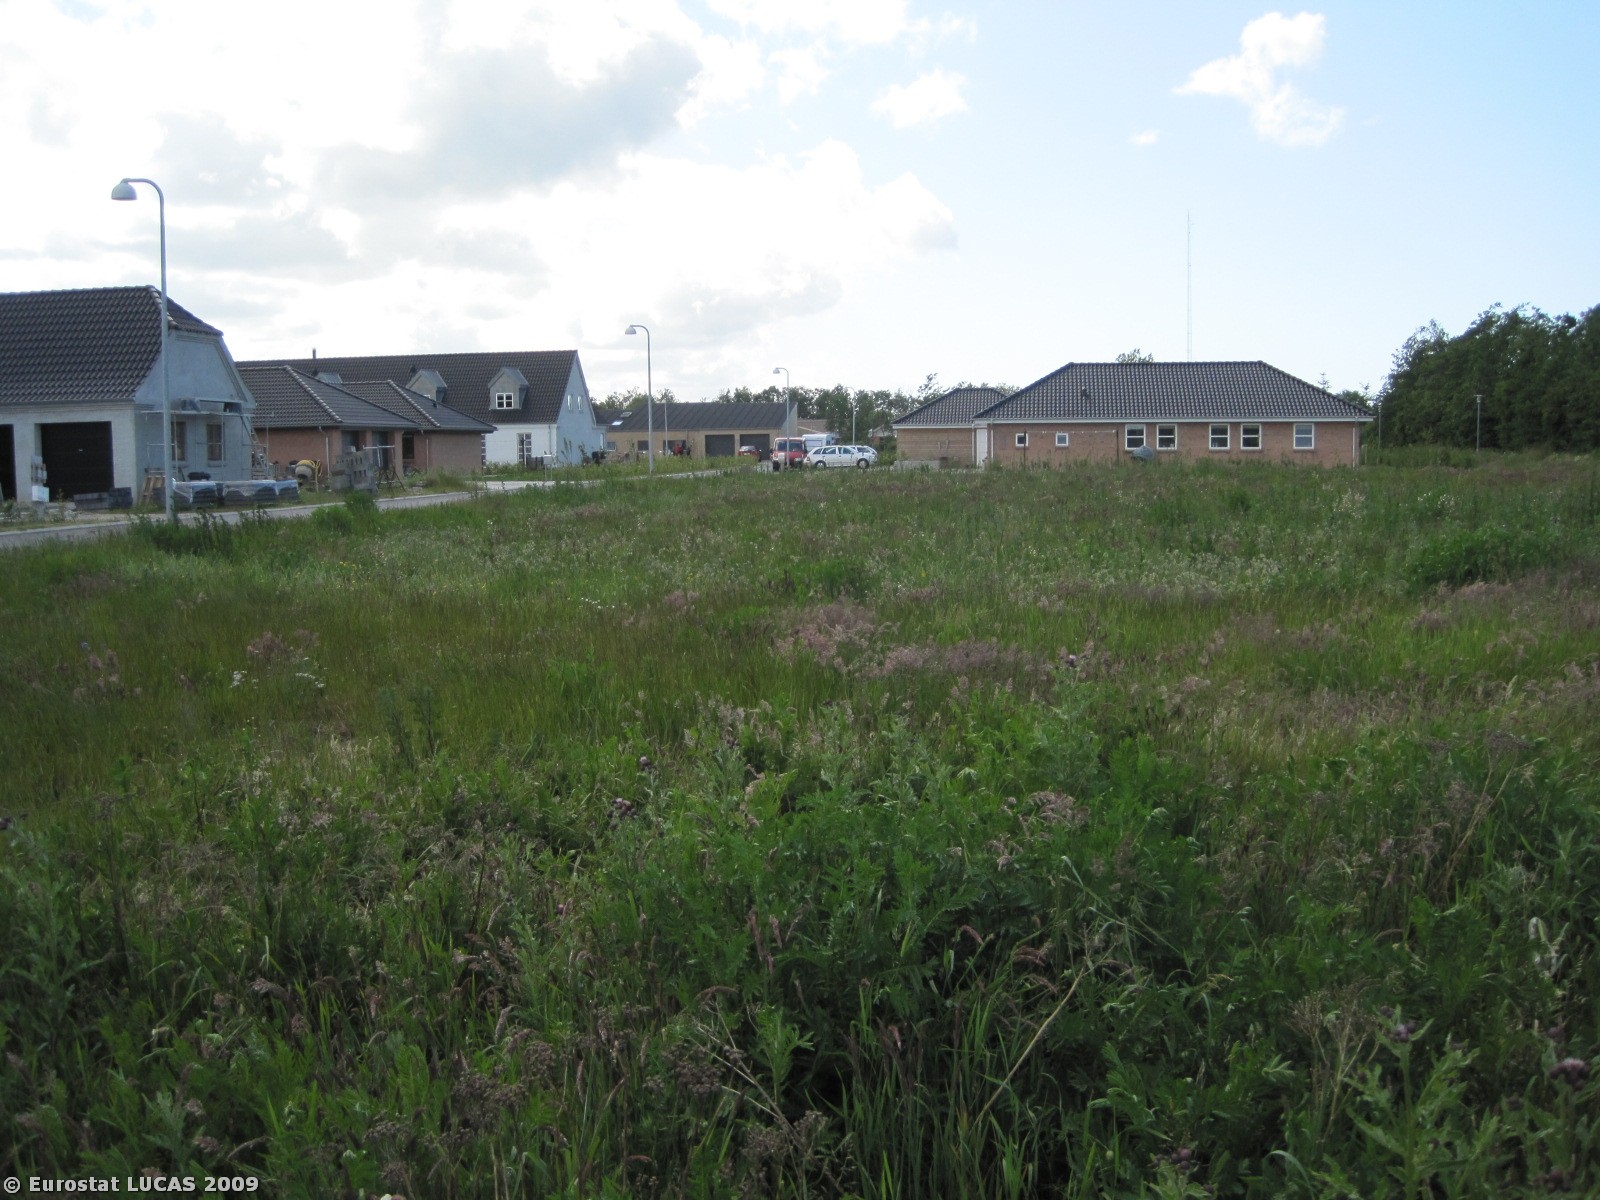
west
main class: Grassland
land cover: Grassland without tree/shrub cover
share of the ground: > 75 %
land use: Unused
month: June
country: DK
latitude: 57.1583
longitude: 9.7524
